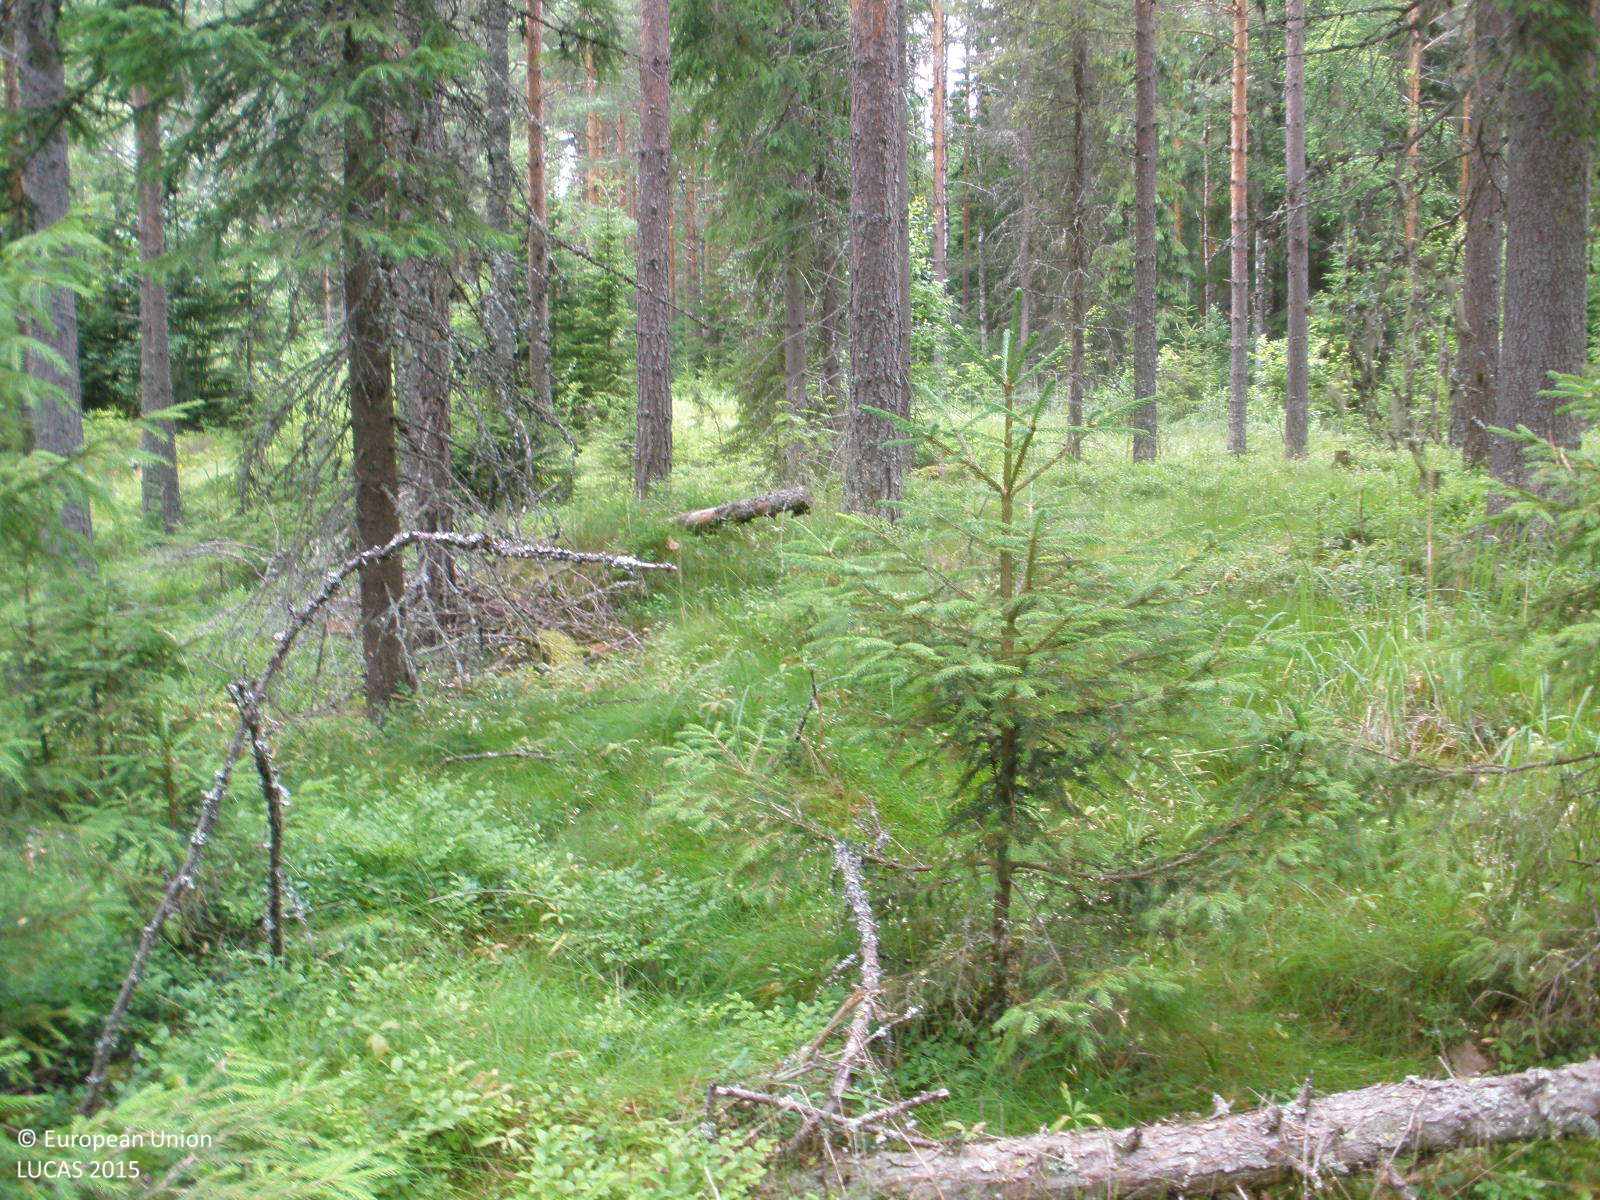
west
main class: Woodland
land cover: Pine dominated coniferous woodland
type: boreal forest
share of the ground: > 75 %
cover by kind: coniferous forest trees 75 %, herbaceous plants 10 %, lichens and mosses 10 %, broadleaved forest trees 5 %
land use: Forestry
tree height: > 5 m
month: July
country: FI
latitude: 61.4186
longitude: 24.5853
